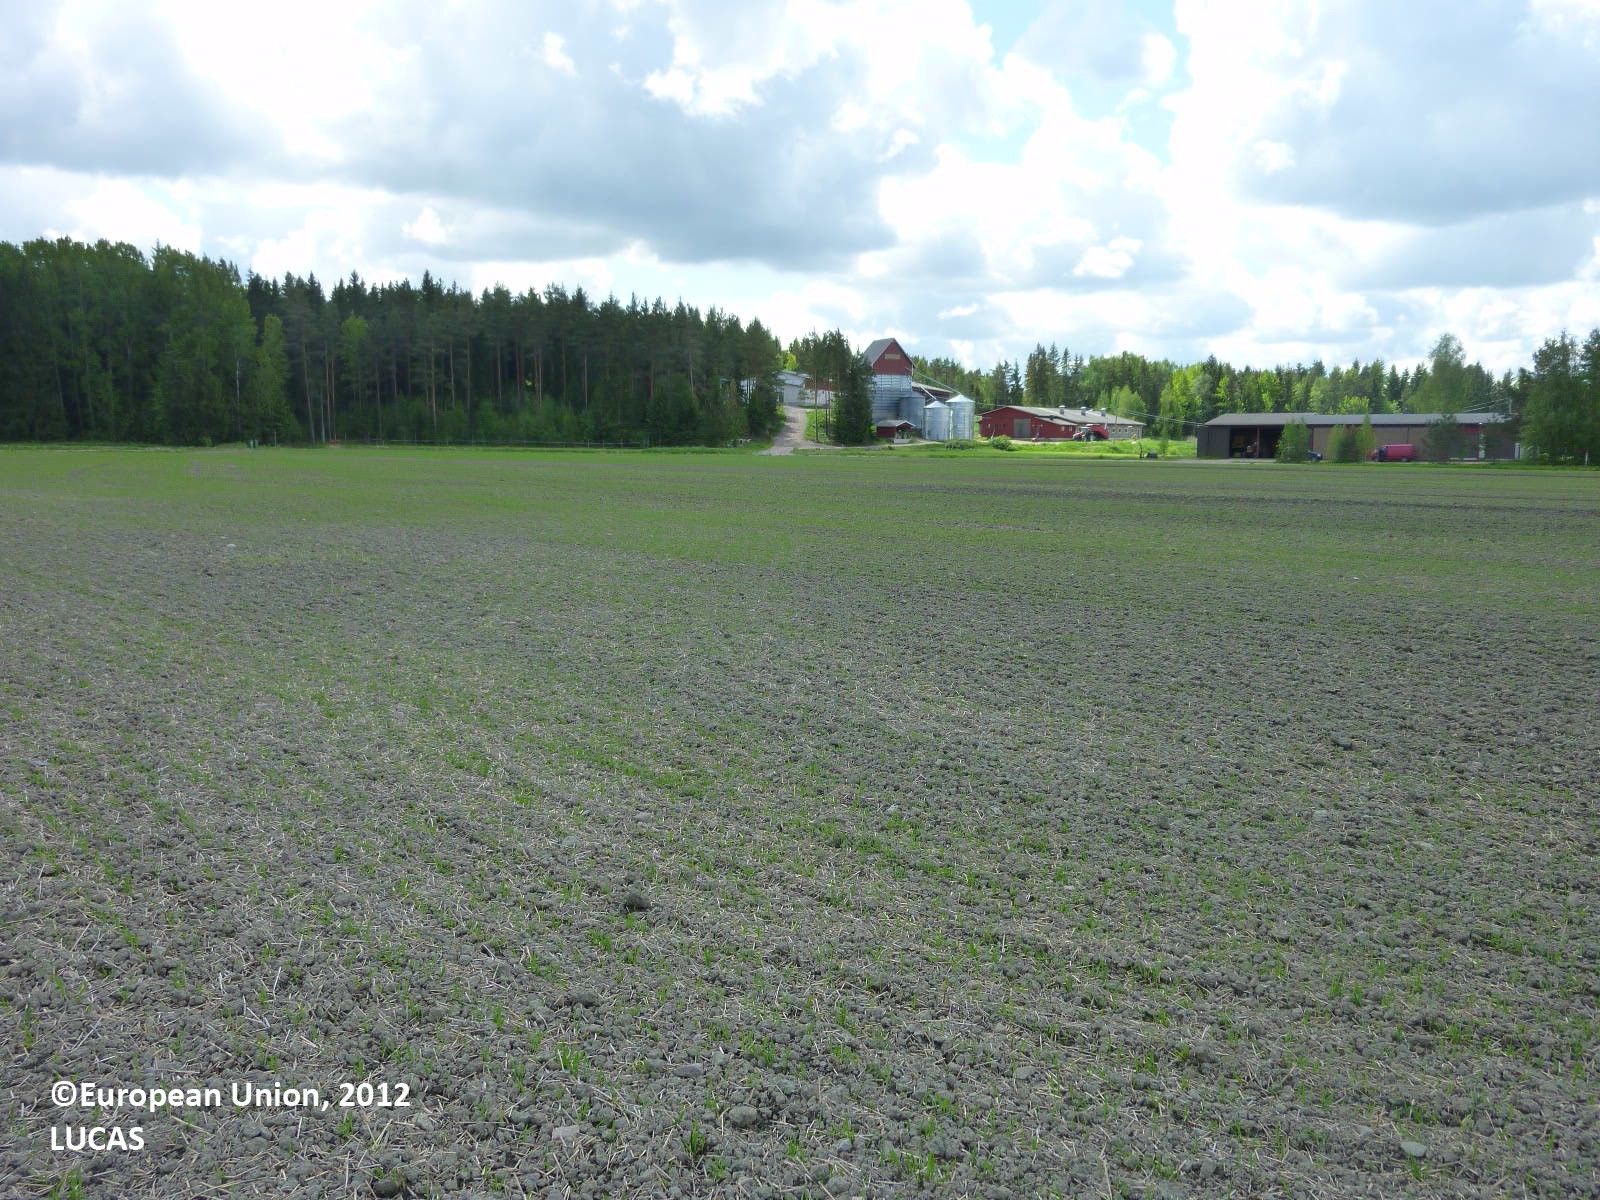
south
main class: Cropland
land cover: Barley
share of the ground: < 10 %
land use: Agriculture (excluding fallow land and kitchen gardens)
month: June
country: FI
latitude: 60.4950
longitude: 22.5397
